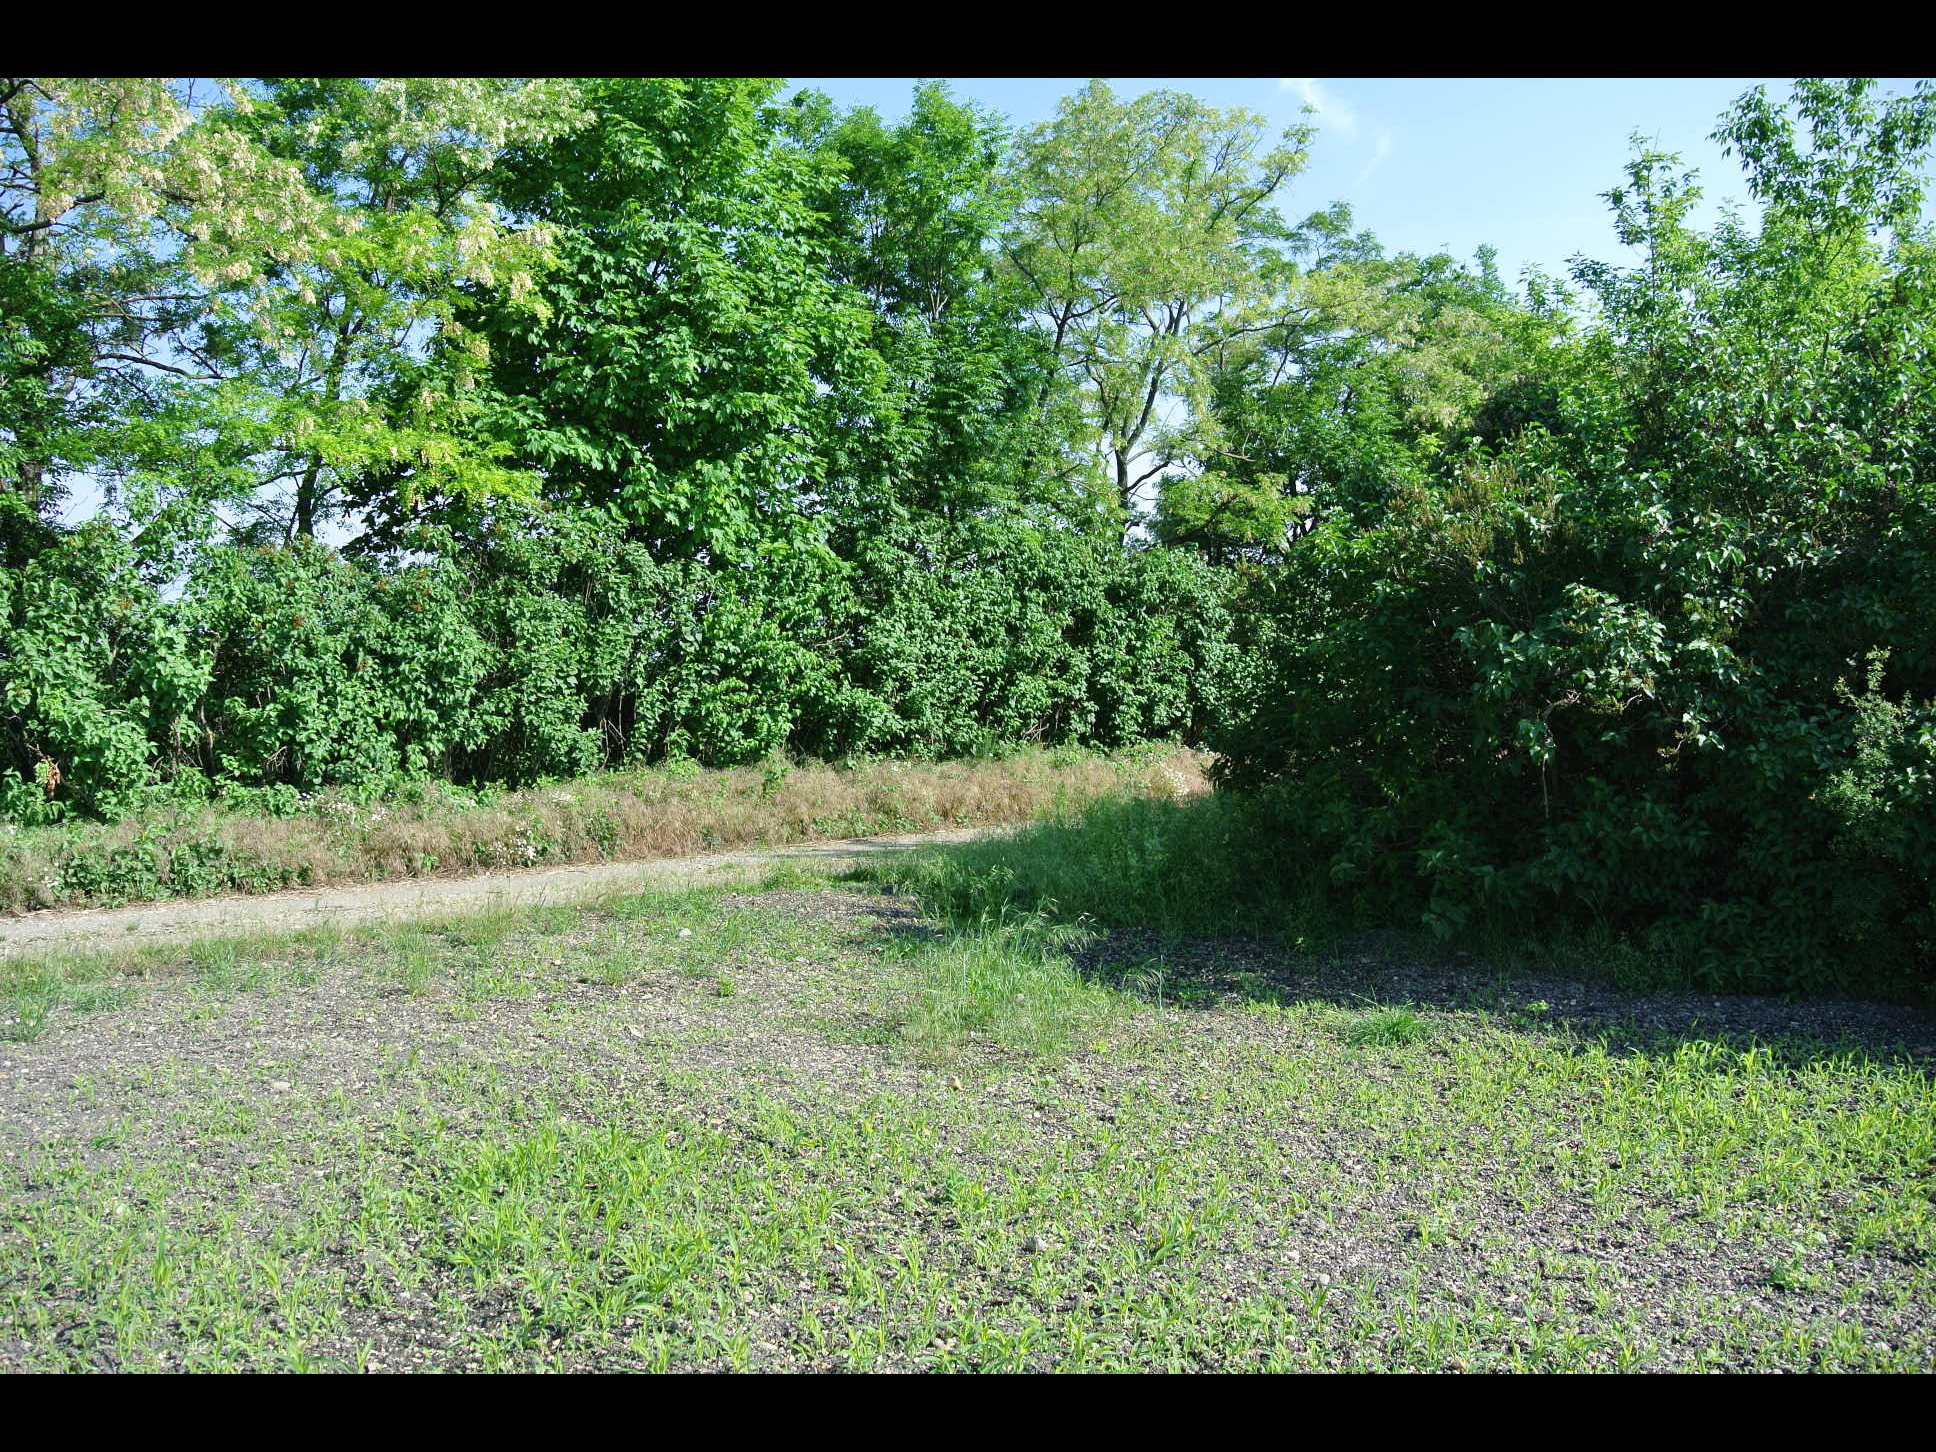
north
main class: Cropland
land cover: Maize
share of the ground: > 75 %
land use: Agriculture (excluding fallow land and kitchen gardens)
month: May
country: AT
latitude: 47.9790
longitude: 16.4757
